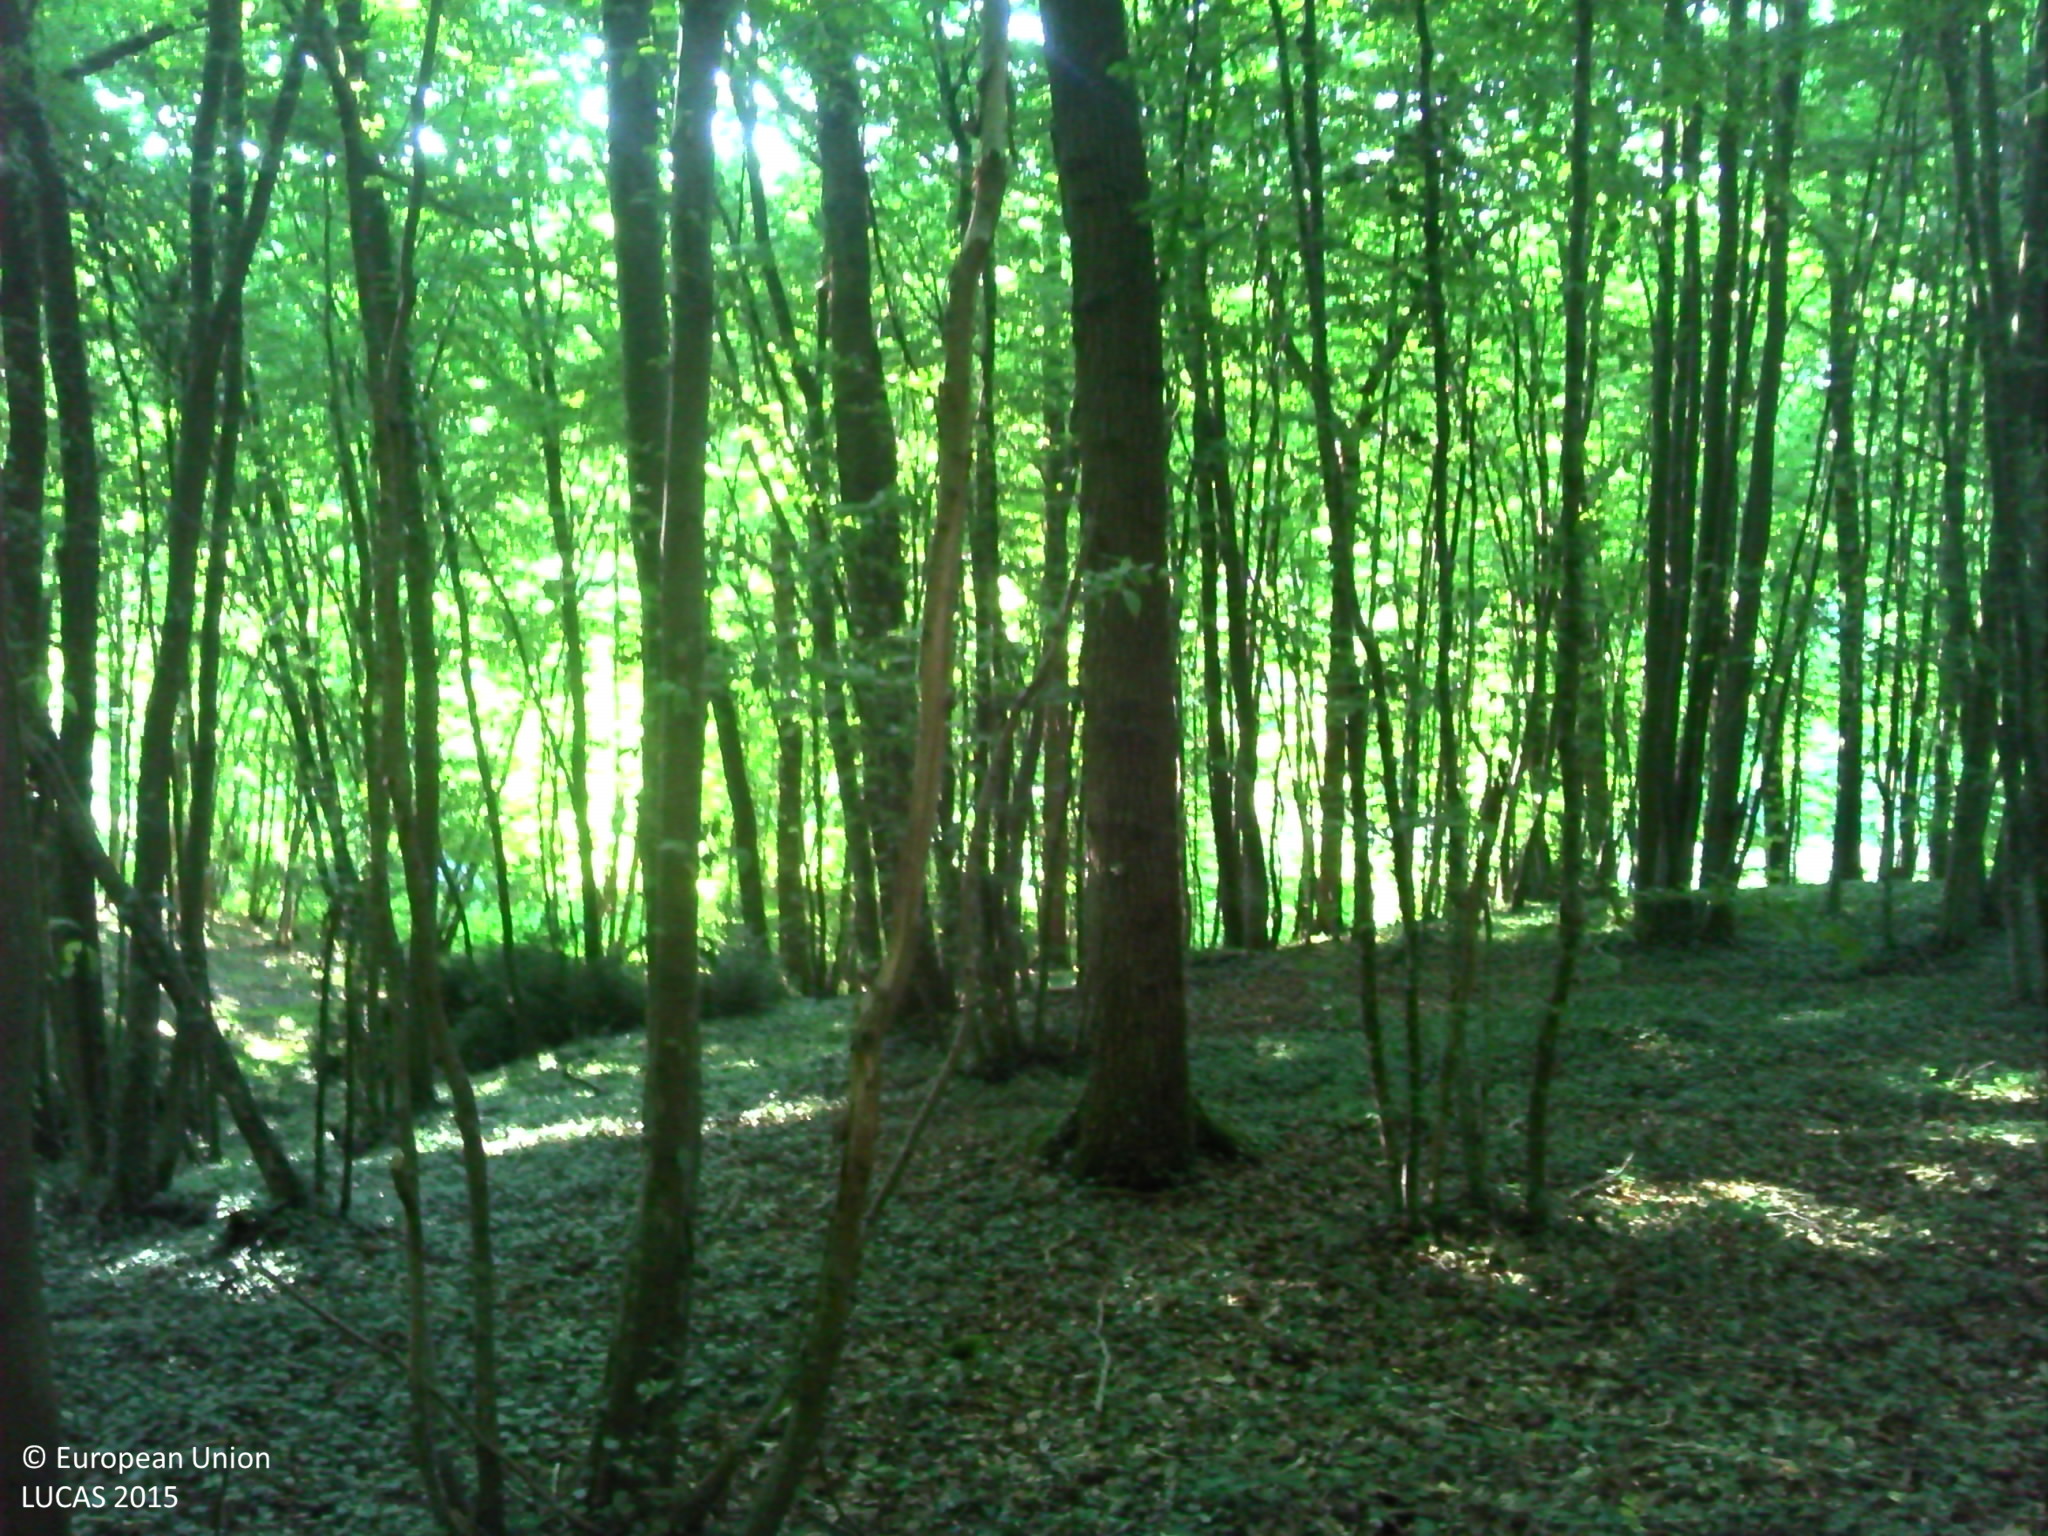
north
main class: Woodland
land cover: Broadleaved woodland
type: mesophytic deciduous forest
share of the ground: > 75 %
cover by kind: broadleaved forest trees 80 %, consolidated bare surface 15 %, herbaceous plants 5 %
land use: Forestry
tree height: > 5 m
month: July
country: FR
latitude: 48.8604
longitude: 1.3531
